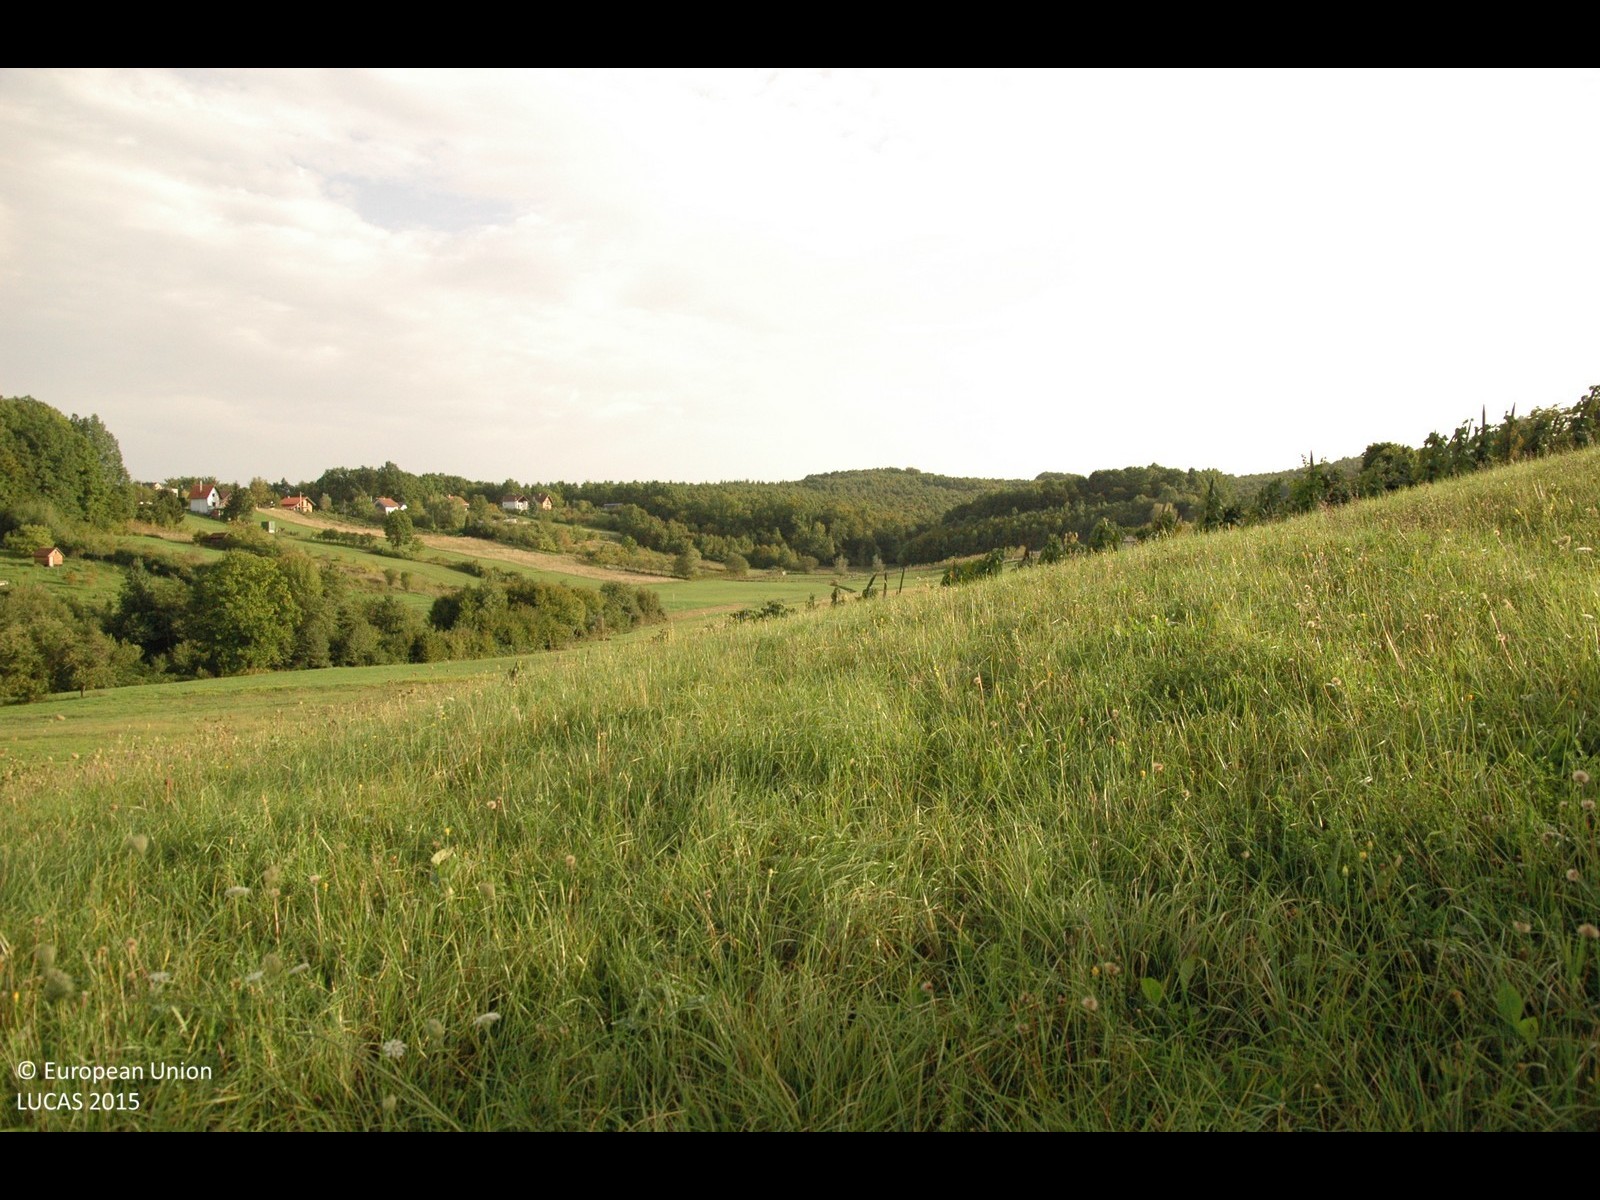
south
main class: Grassland
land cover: Grassland without tree/shrub cover
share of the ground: > 75 %
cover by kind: herbaceous plants 100 %
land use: Agriculture (excluding fallow land and kitchen gardens)
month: September
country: HR
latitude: 45.6444
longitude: 15.9378
